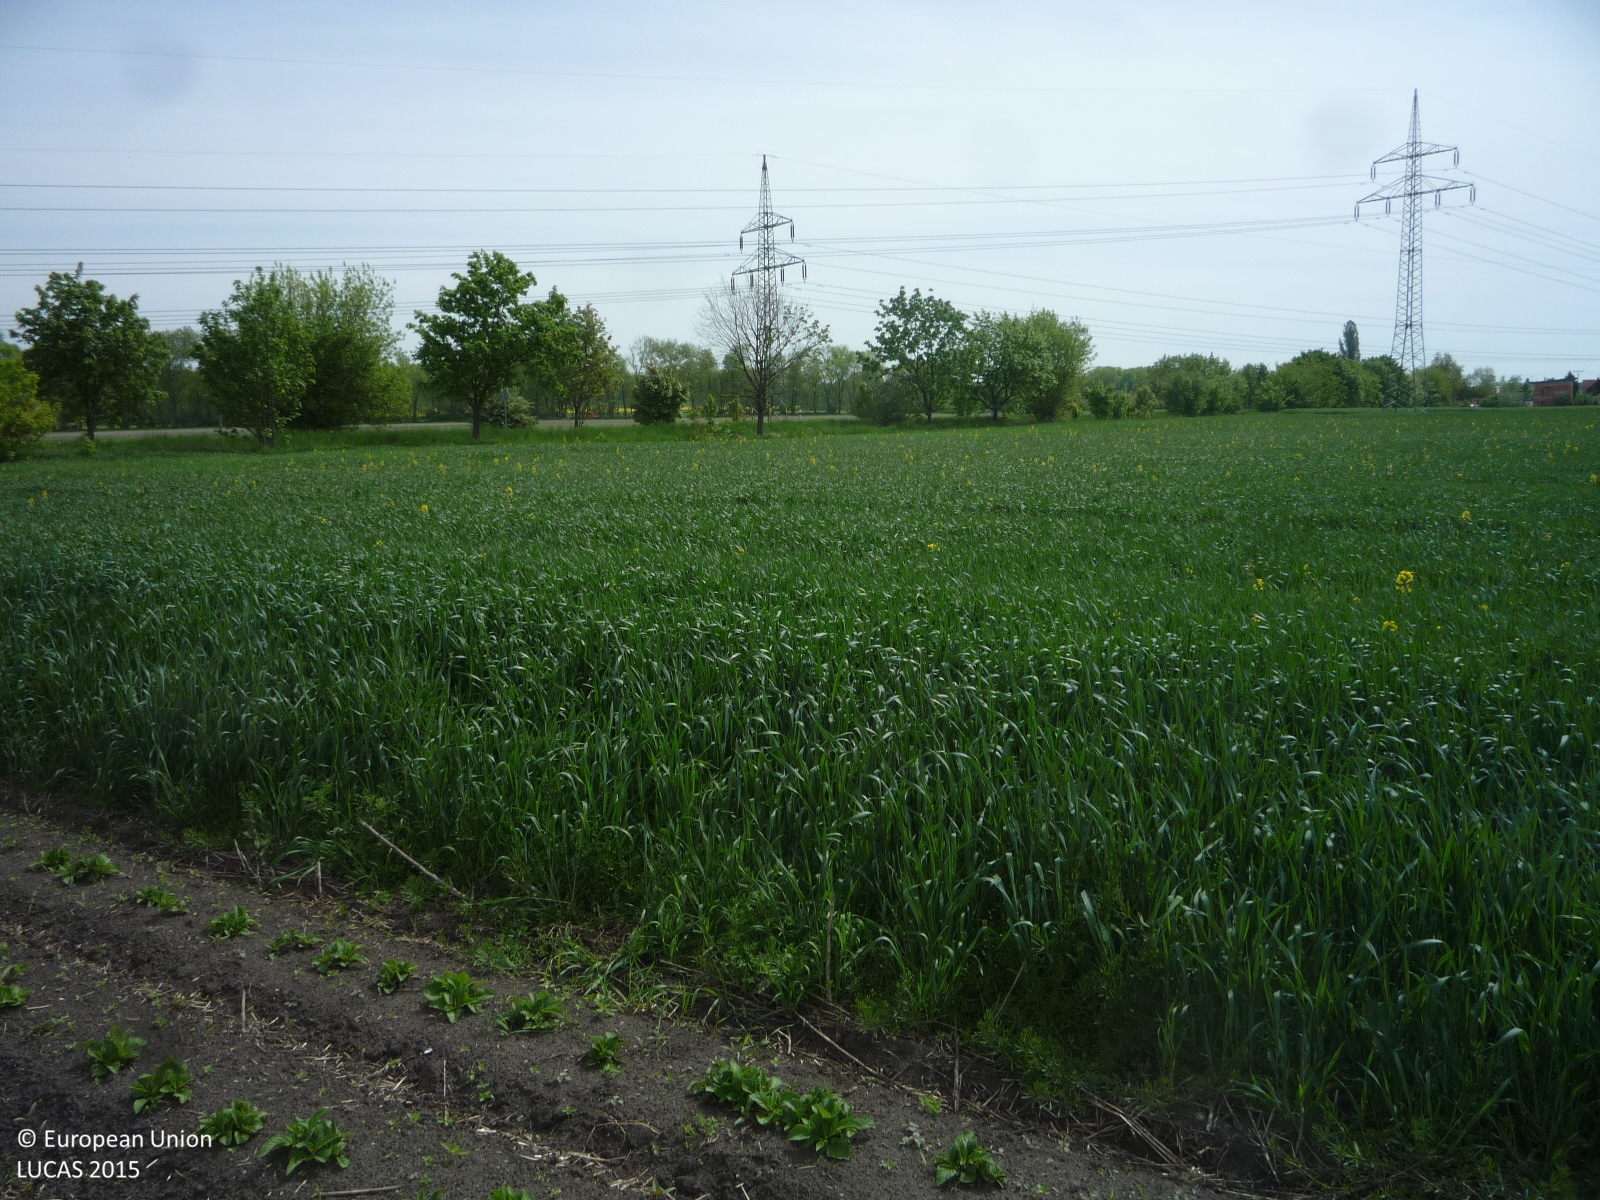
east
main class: Cropland
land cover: Potatoes
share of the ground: 10 - 25 %
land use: Agriculture (excluding fallow land and kitchen gardens)
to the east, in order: Potatoes; Common wheat; Lines of trees; Ditches and canals; Grassland without tree/shrub cover; Paved roads, cycling and walking lanes; Grassland without tree/shrub cover; Ditches and canals; Lines of trees; Potatoes; Electric lines; Potatoes; Barley; Electric lines; Barley
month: May
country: CZ
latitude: 50.3280
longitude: 14.5391
